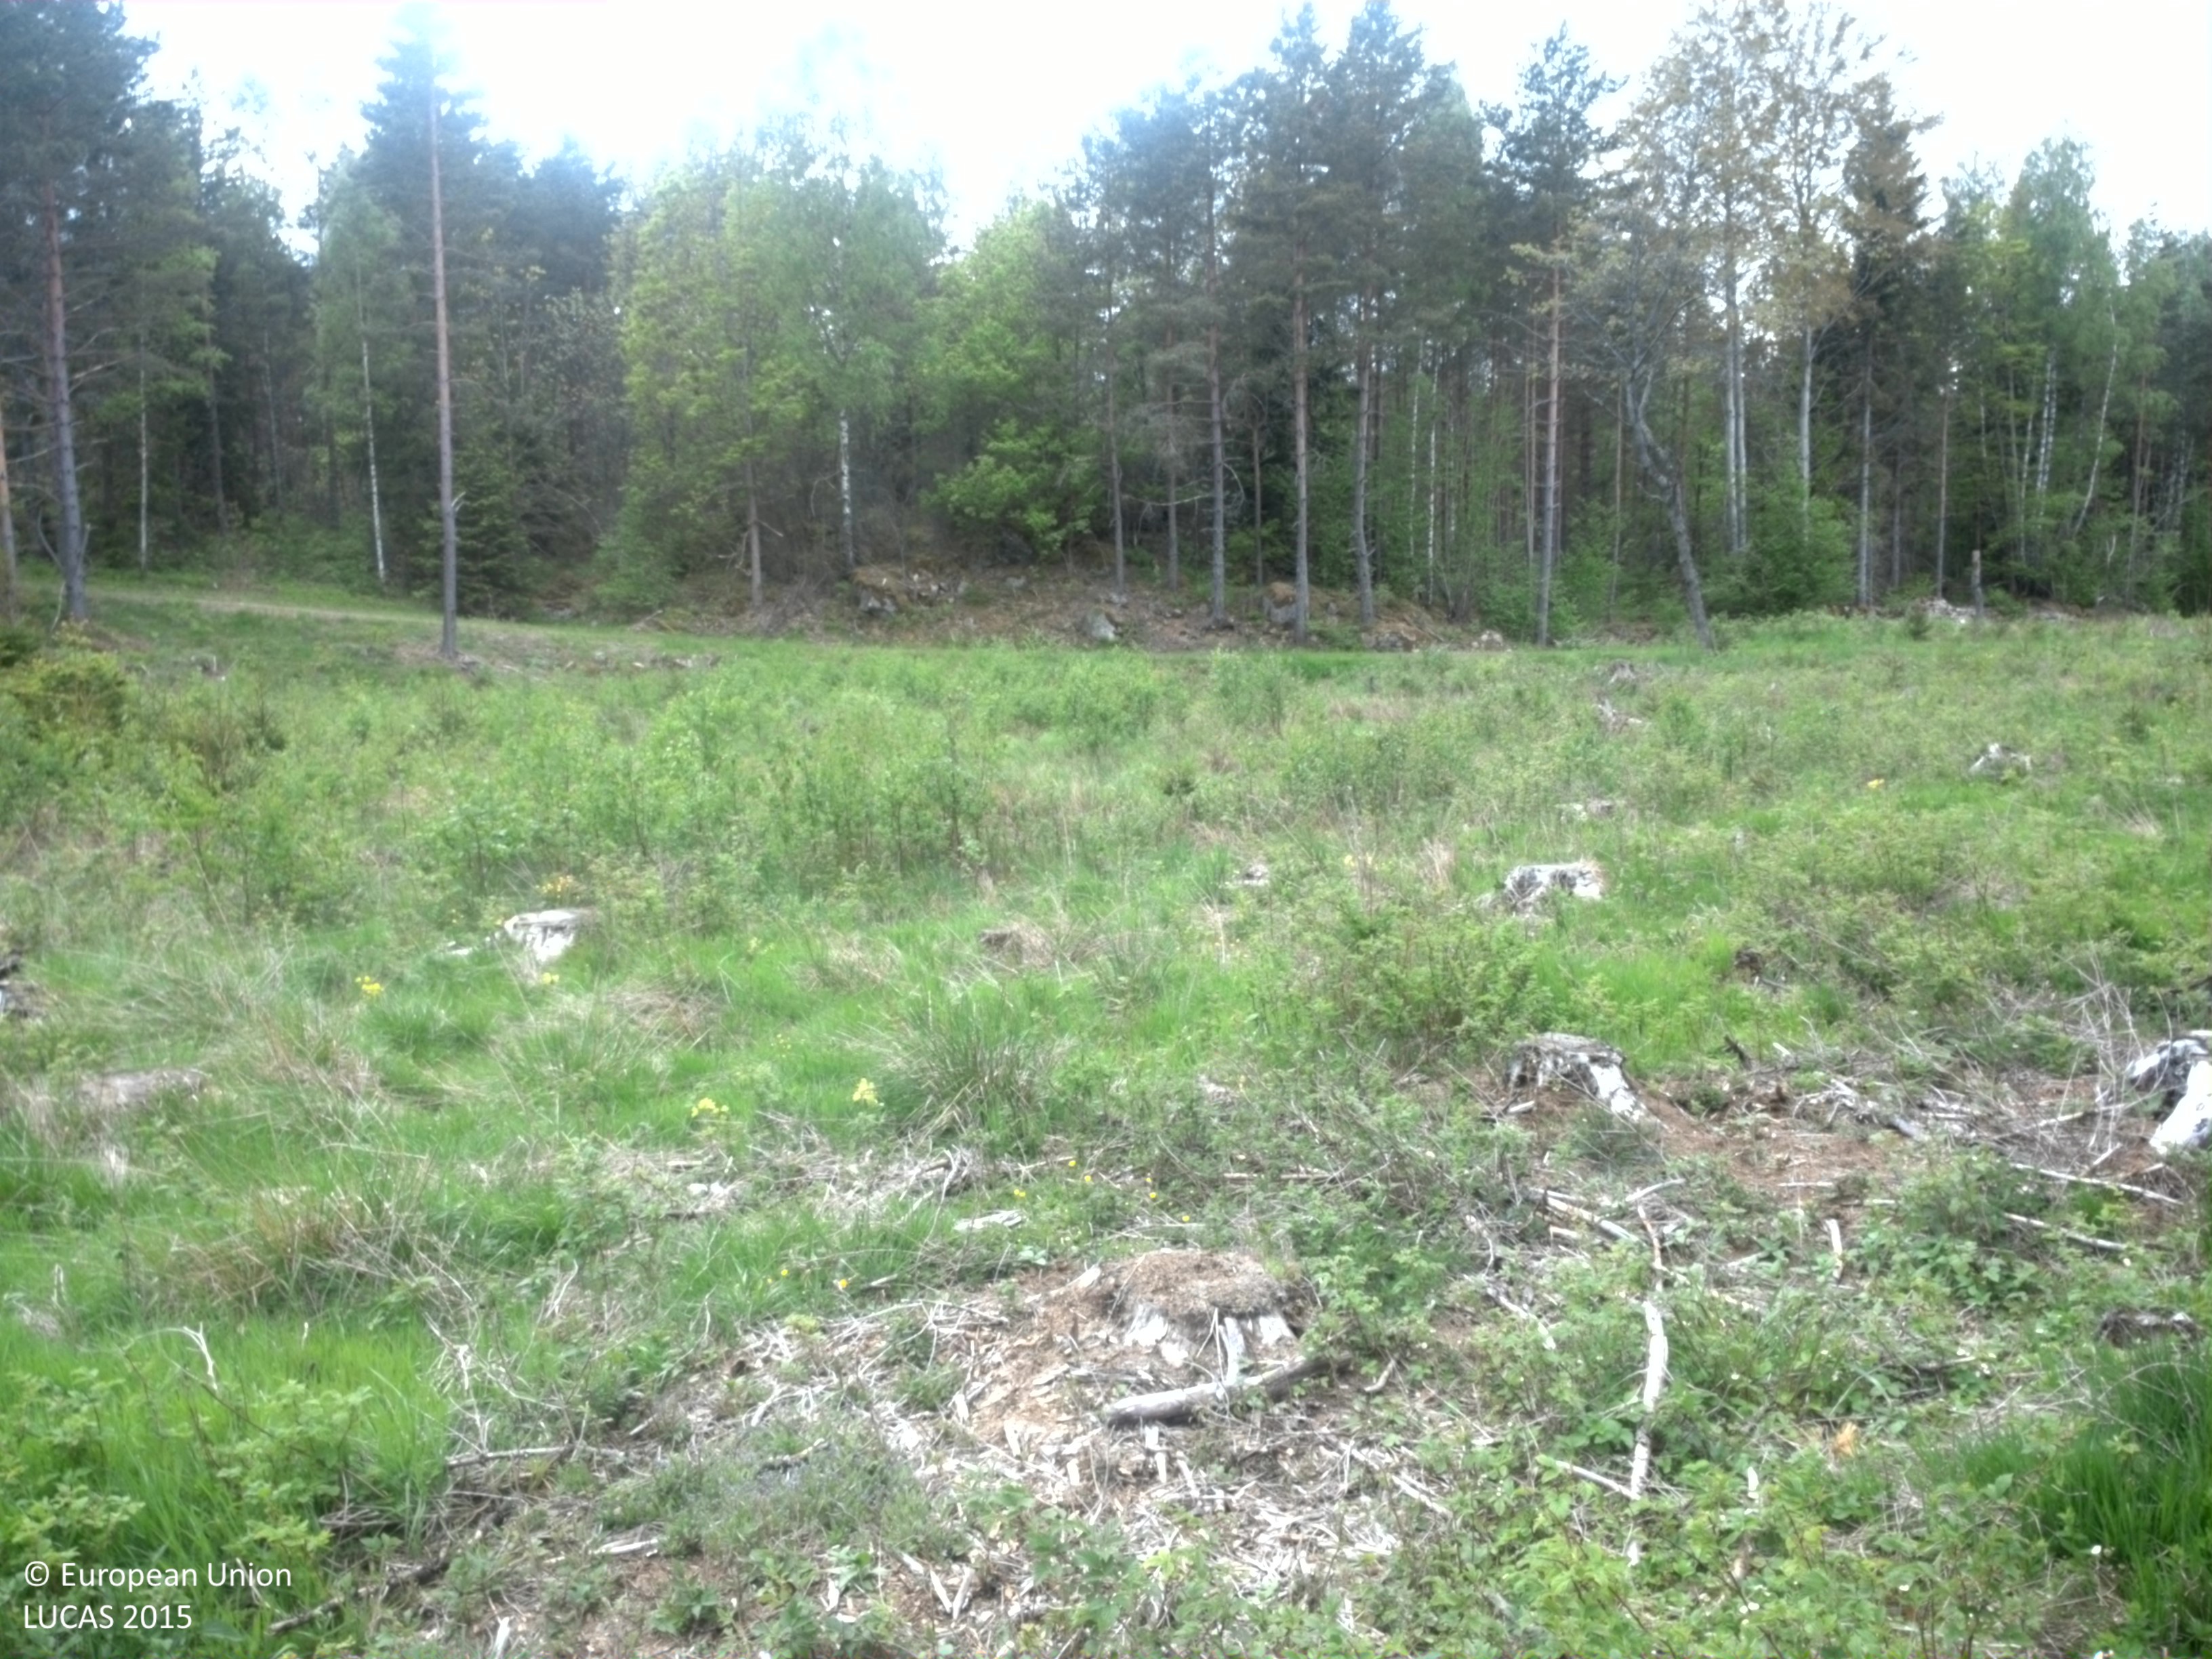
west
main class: Shrubland
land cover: Shrubland with sparse tree cover
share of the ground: 25 - 50 %
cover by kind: shrubs 45 %, herbaceous plants 30 %, lichens and mosses 10 %, consolidated bare surface 10 %, broadleaved forest trees 5 %
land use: Forestry
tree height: < 5 m
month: May
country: SE
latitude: 57.2729
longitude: 16.0186
